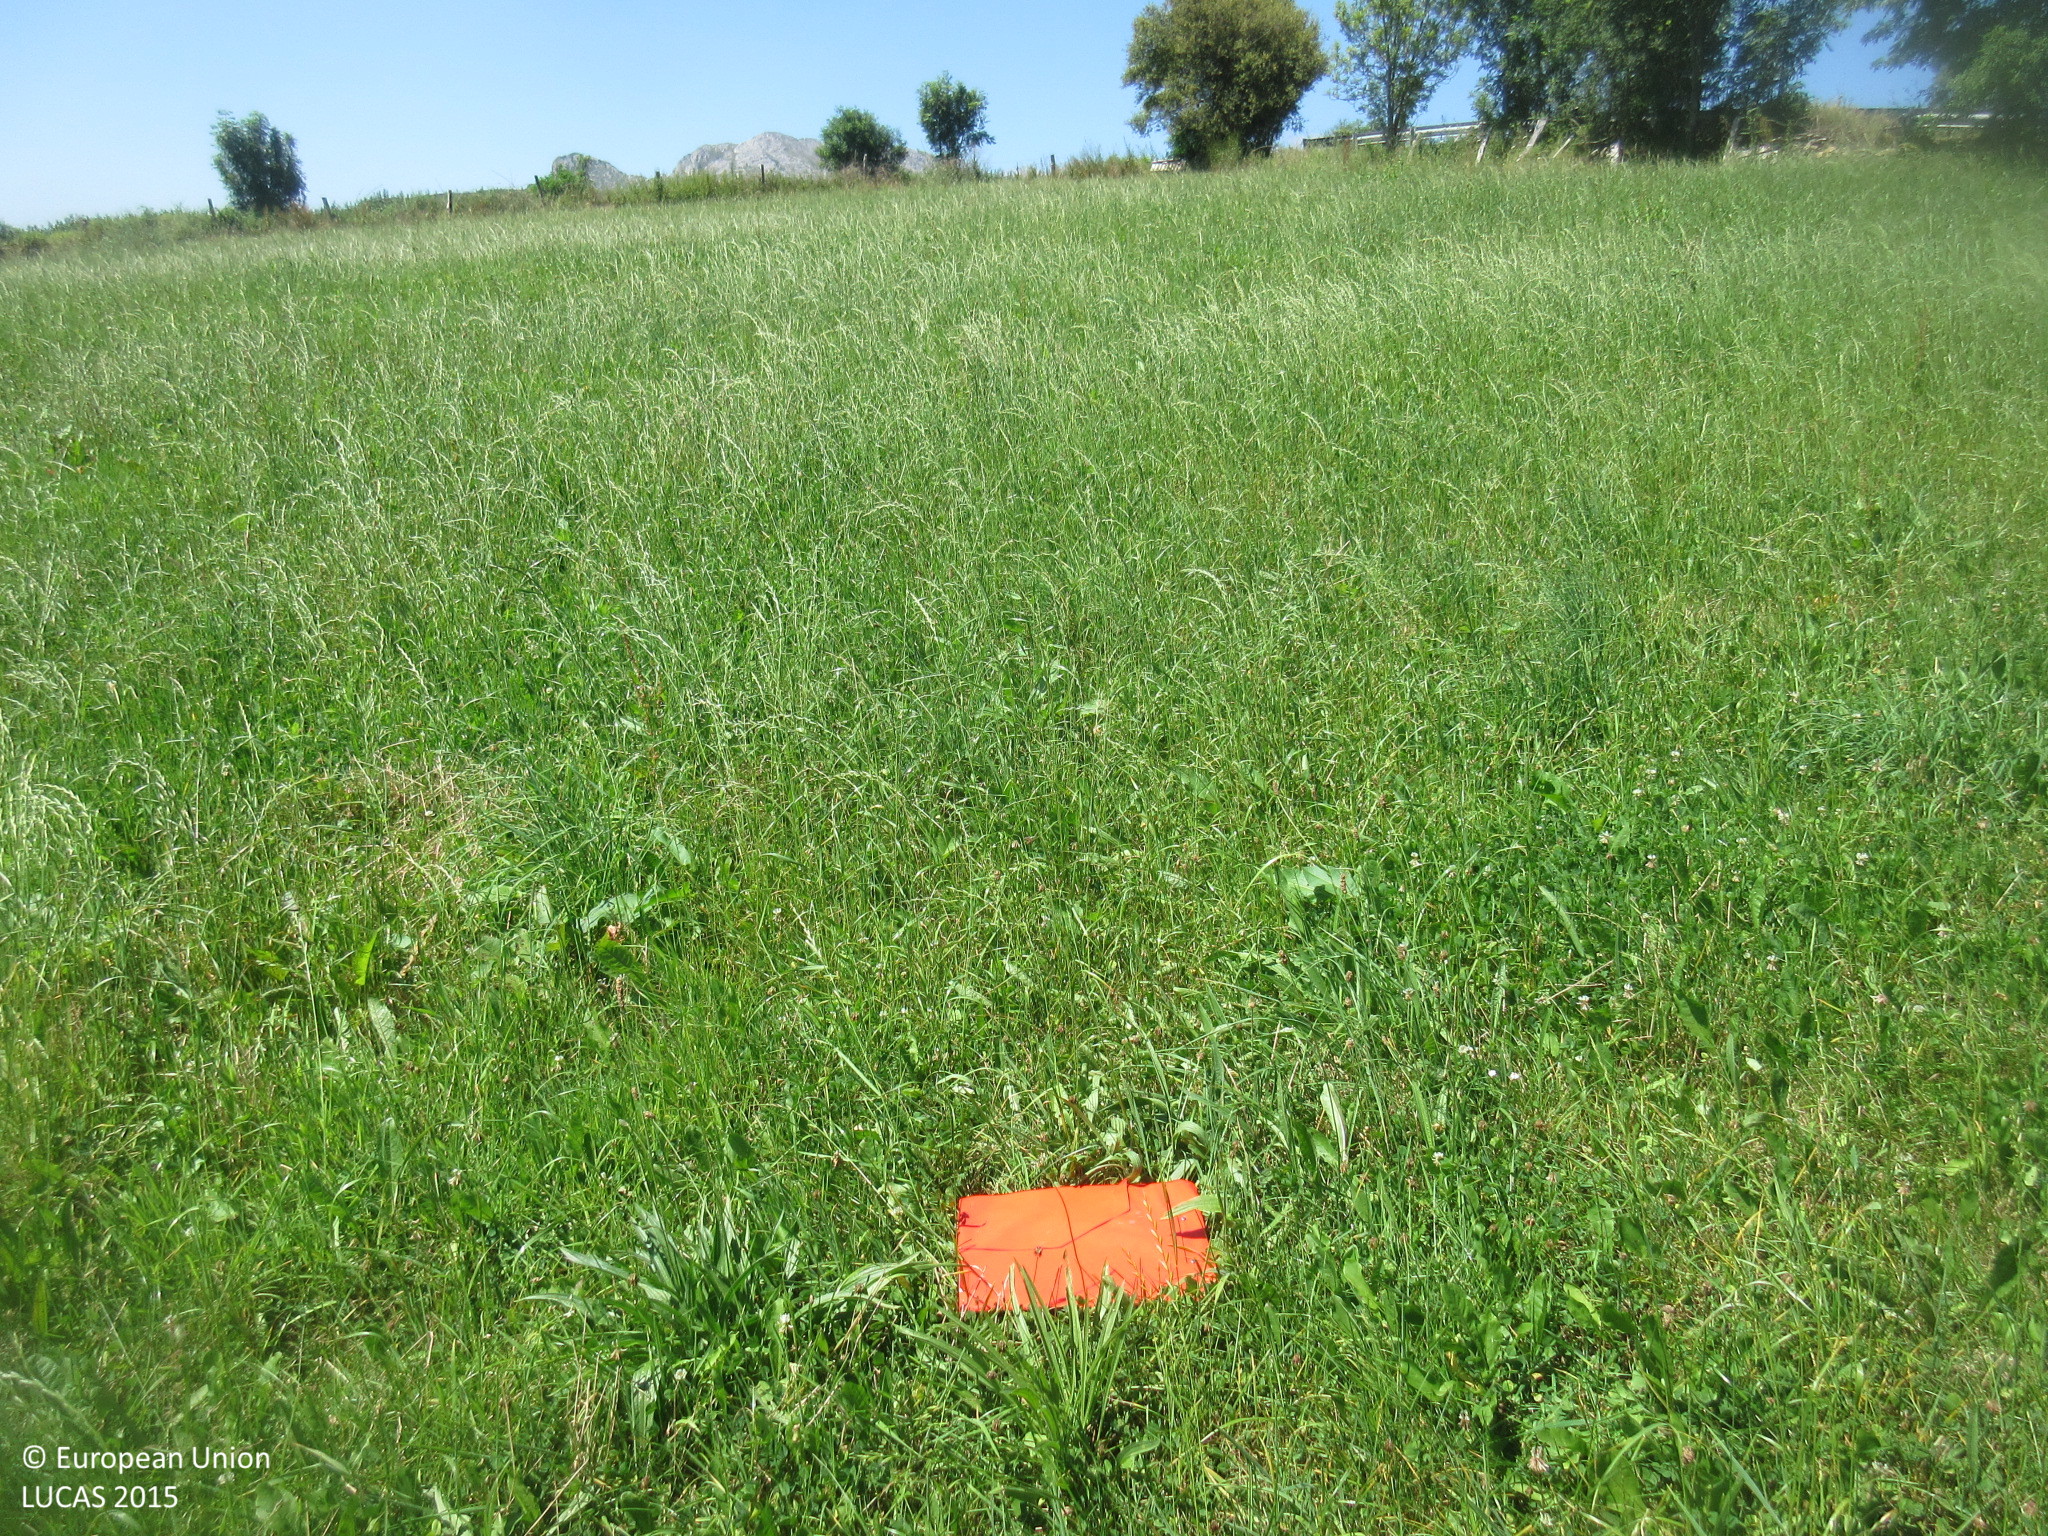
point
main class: Grassland
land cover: Grassland without tree/shrub cover
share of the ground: > 75 %
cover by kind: herbaceous plants 100 %
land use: Agriculture (excluding fallow land and kitchen gardens)
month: July
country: ES
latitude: 43.2183
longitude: -3.4222
